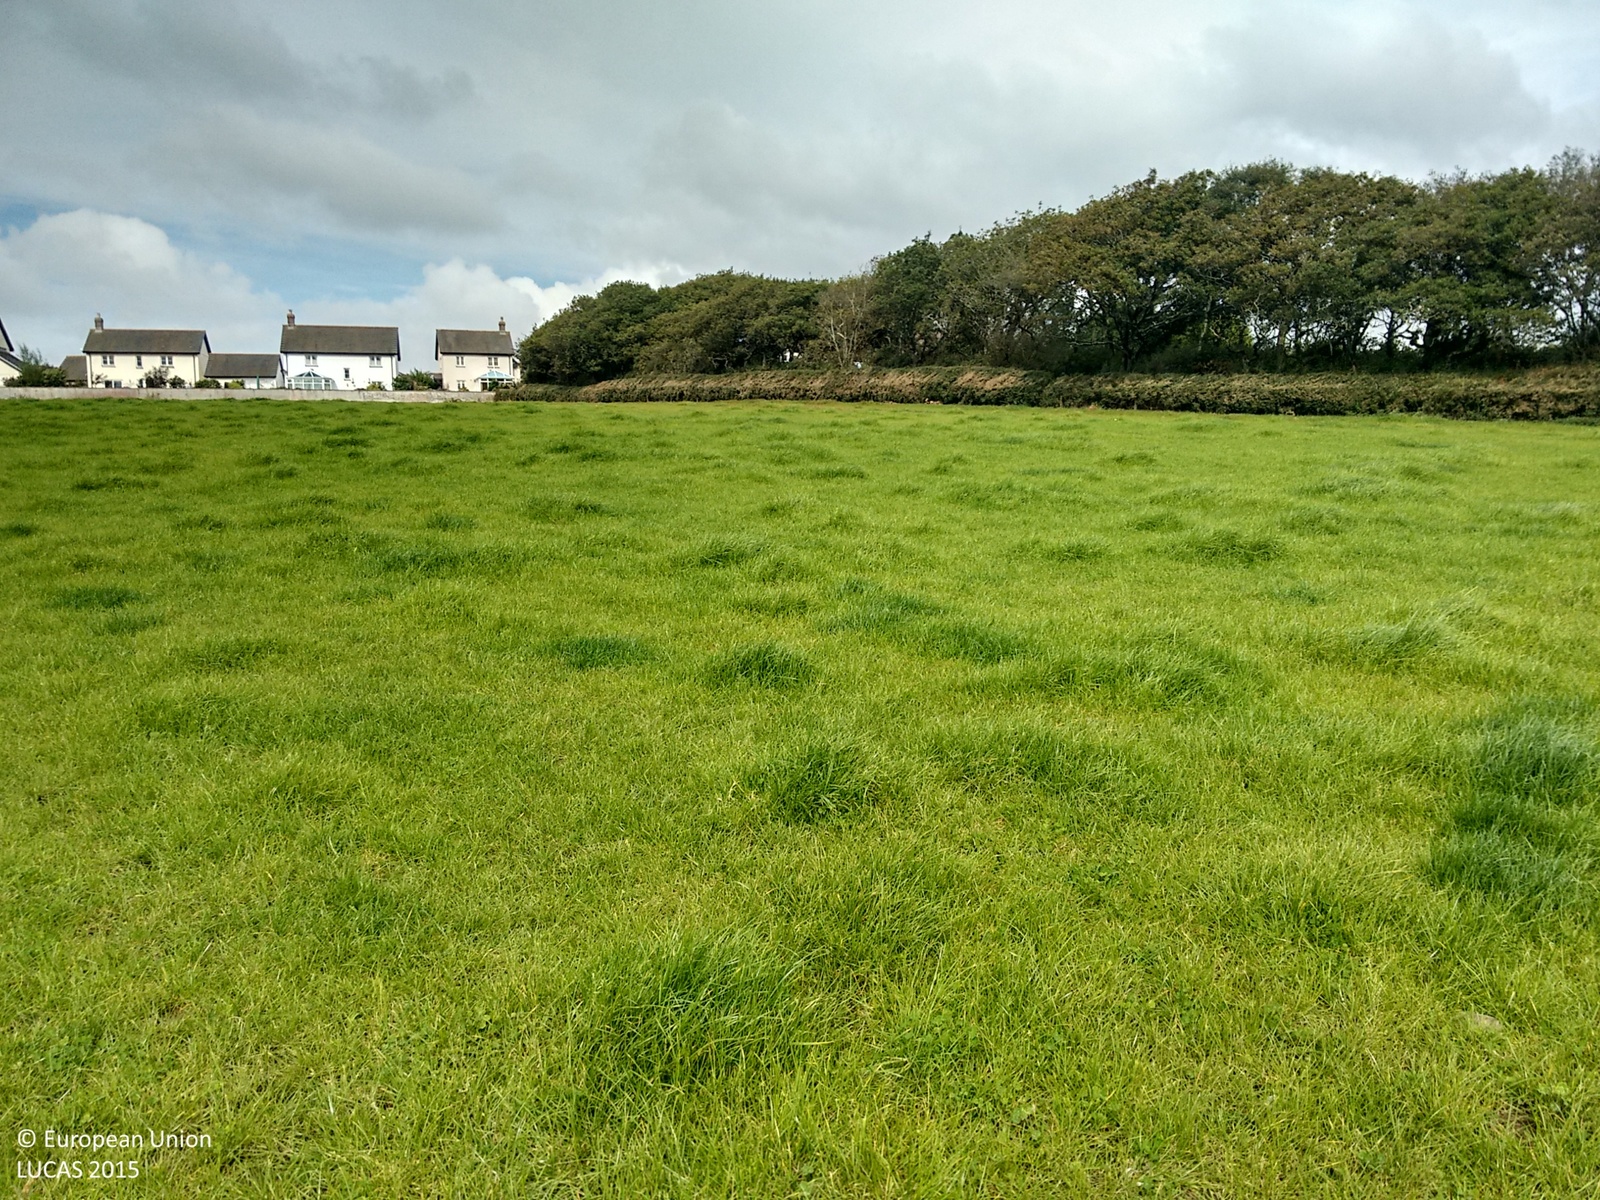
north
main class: Grassland
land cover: Grassland without tree/shrub cover
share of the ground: > 75 %
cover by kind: herbaceous plants 100 %
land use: Agriculture (excluding fallow land and kitchen gardens)
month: September
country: GB
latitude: 50.8000
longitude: -4.3903
